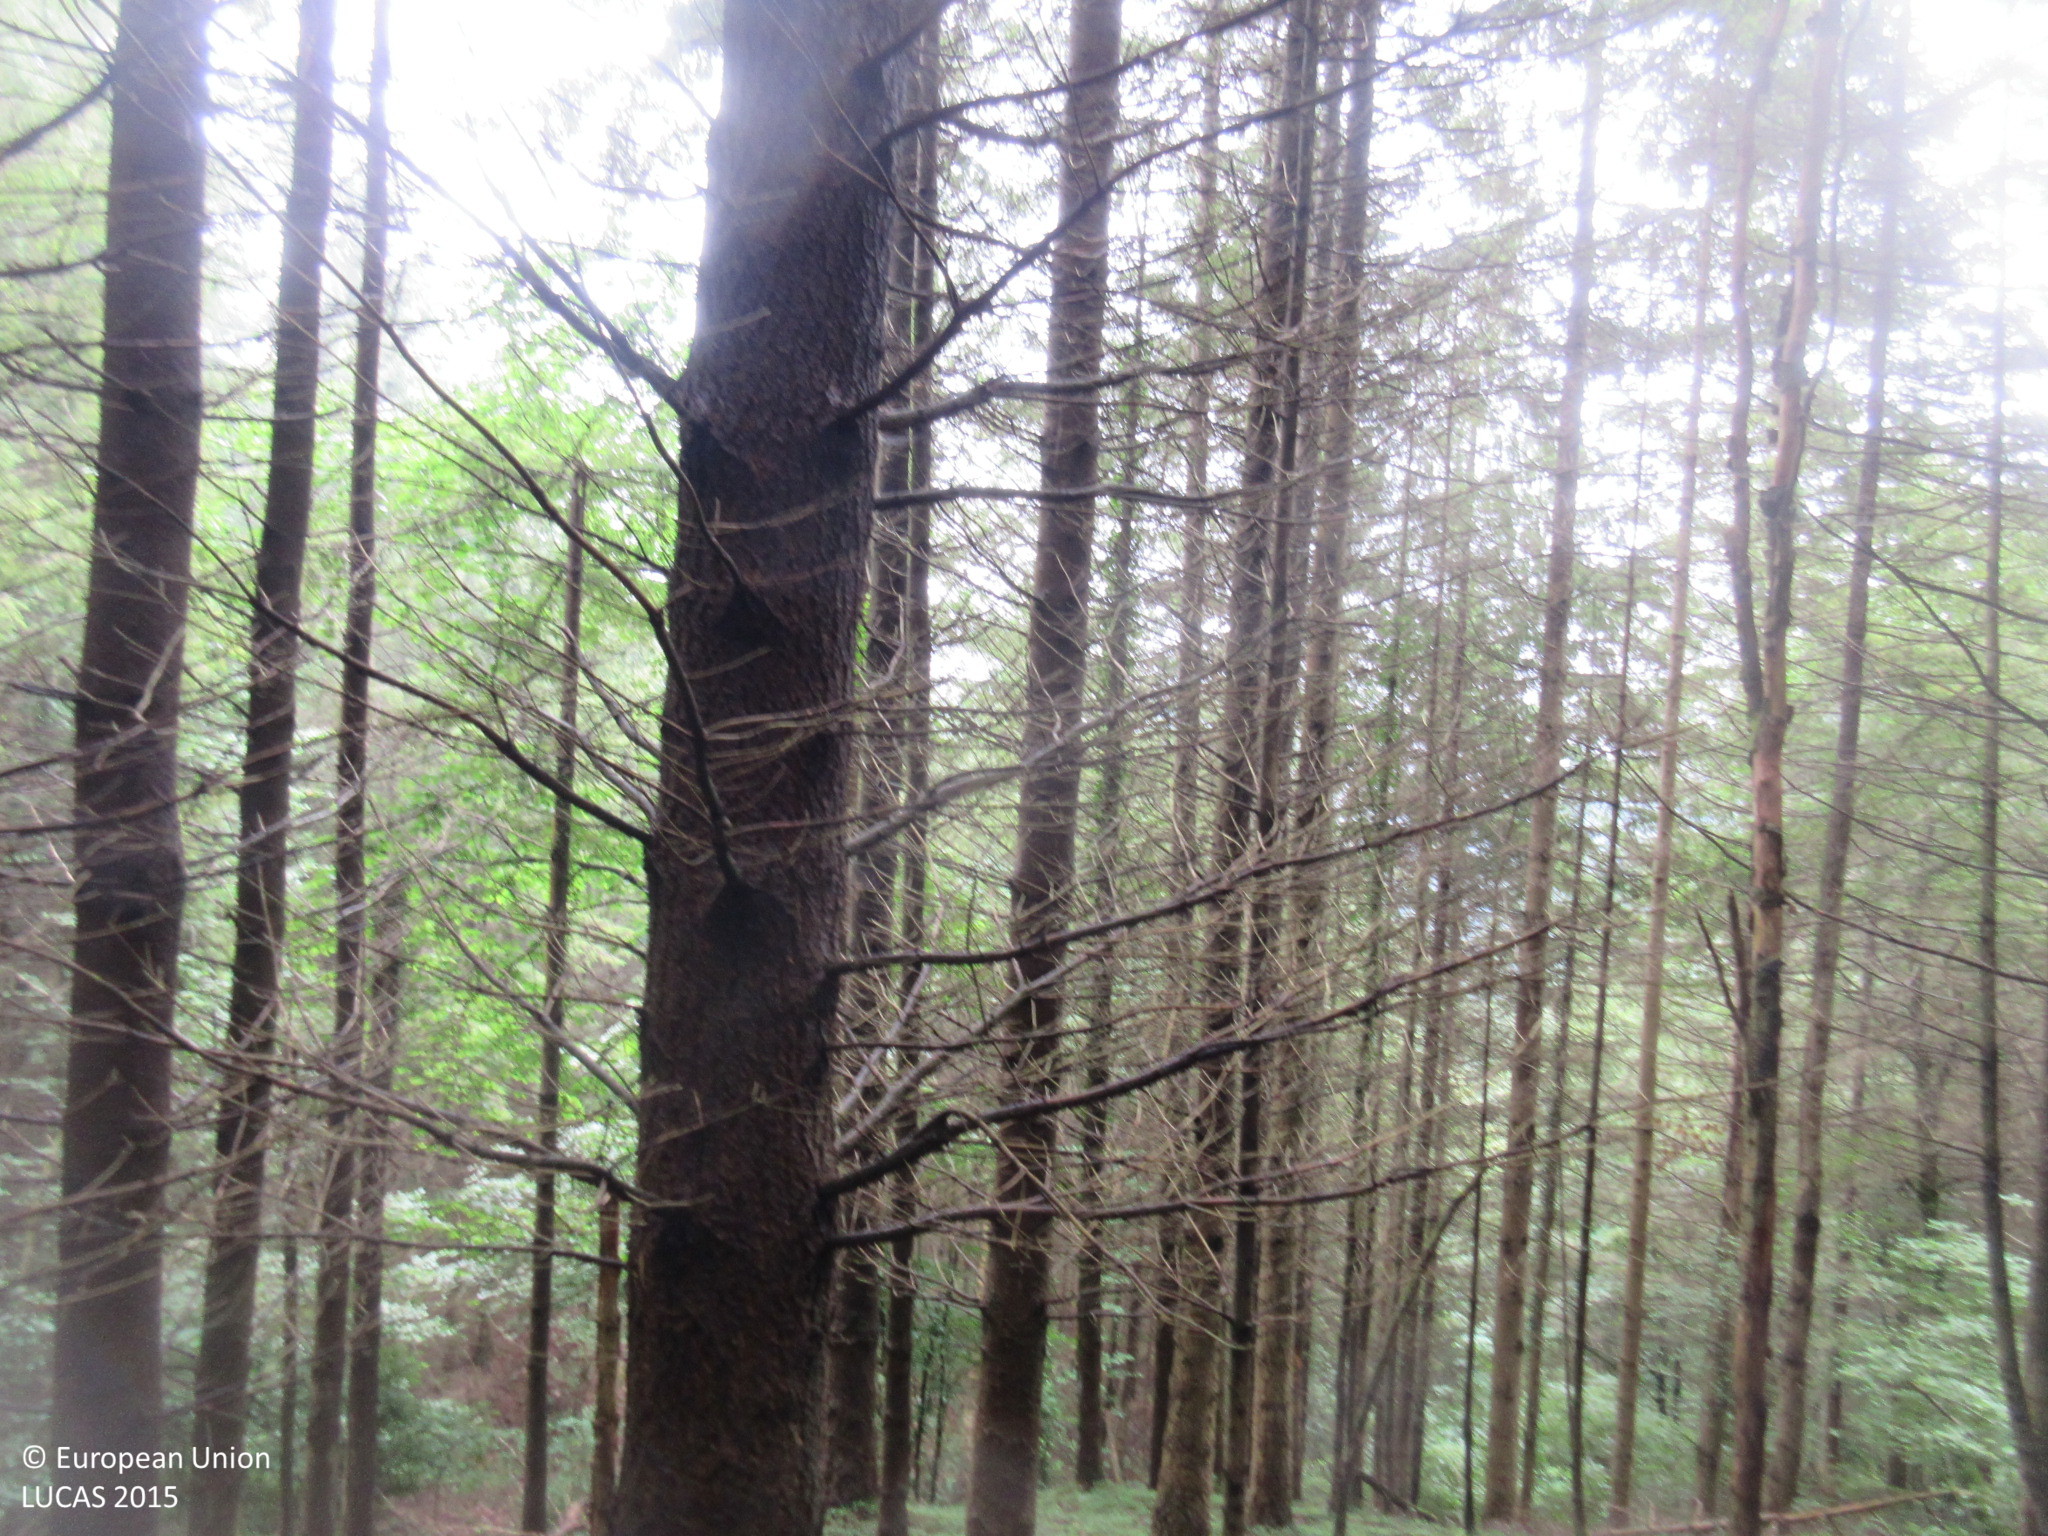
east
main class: Woodland
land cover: Spruce dominated coniferous woodland
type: hemiboreal forest and nemoral coniferous forest and mixed broadleaved-coniferous forest
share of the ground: > 75 %
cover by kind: coniferous forest trees 100 %
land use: Forestry
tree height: > 5 m
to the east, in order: Spruce dominated coniferous woodland; Broadleaved woodland; Spruce dominated coniferous woodland
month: July
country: ES
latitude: 43.2931
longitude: -5.2215
